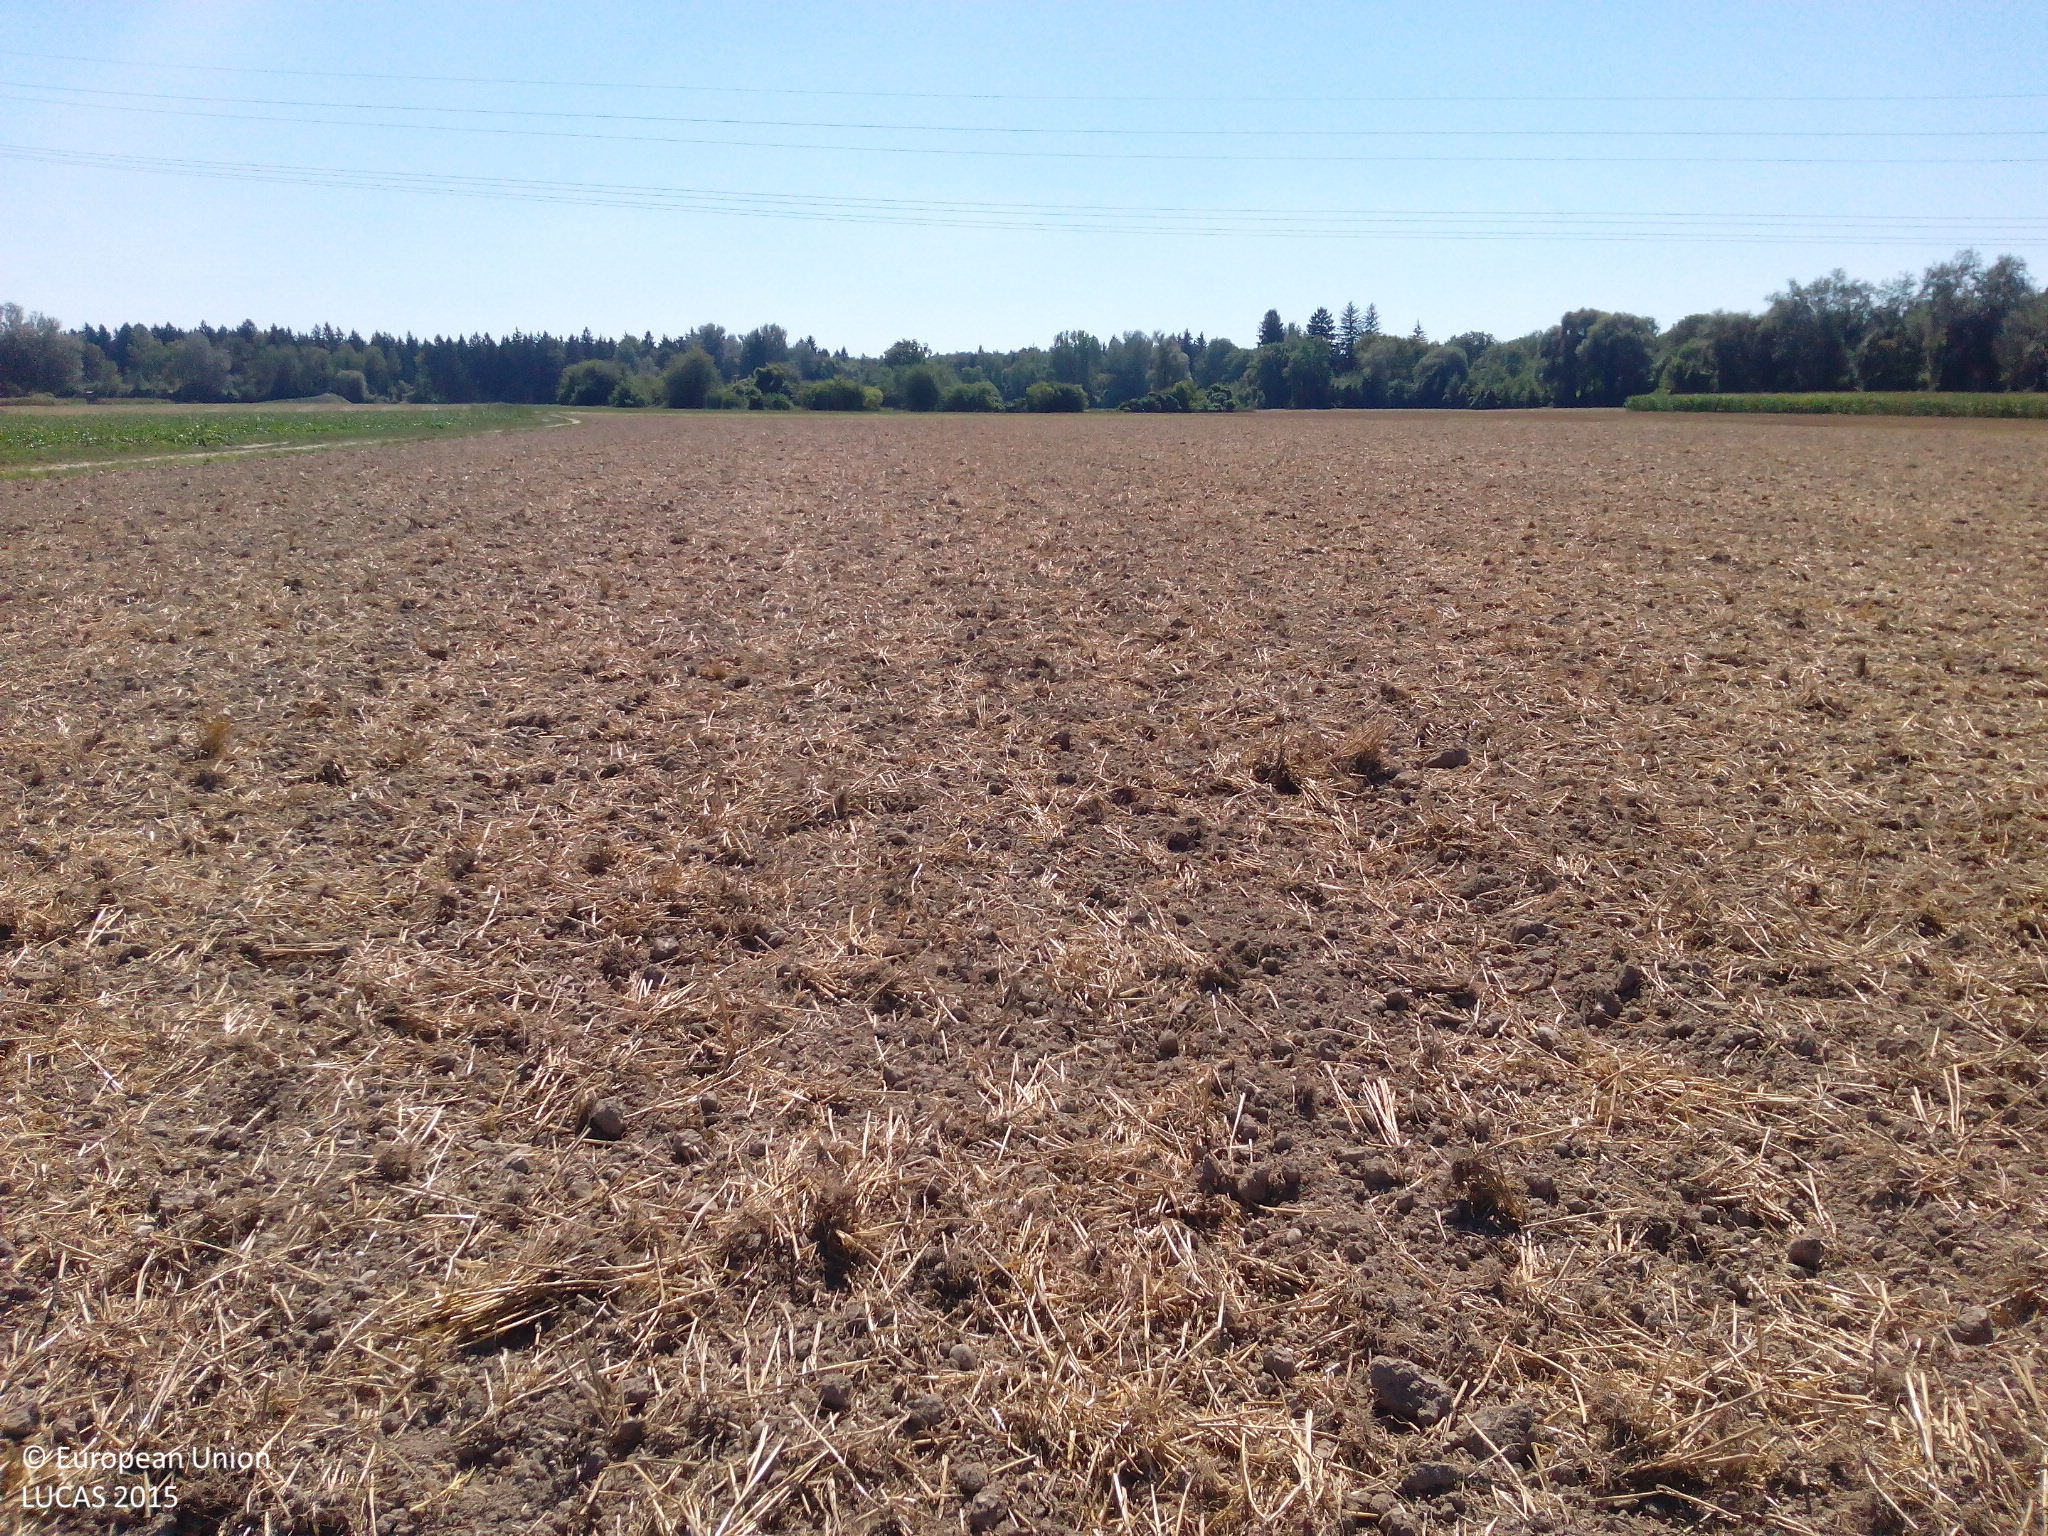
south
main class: Artificial land
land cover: Other artificial areas
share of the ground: < 10 %
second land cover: Common wheat
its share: < 10 %
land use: Electricity, gas and thermal power distribution
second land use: Agriculture (excluding fallow land and kitchen gardens)
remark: Harvested field
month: August
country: DE
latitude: 48.5439
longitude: 10.8800
